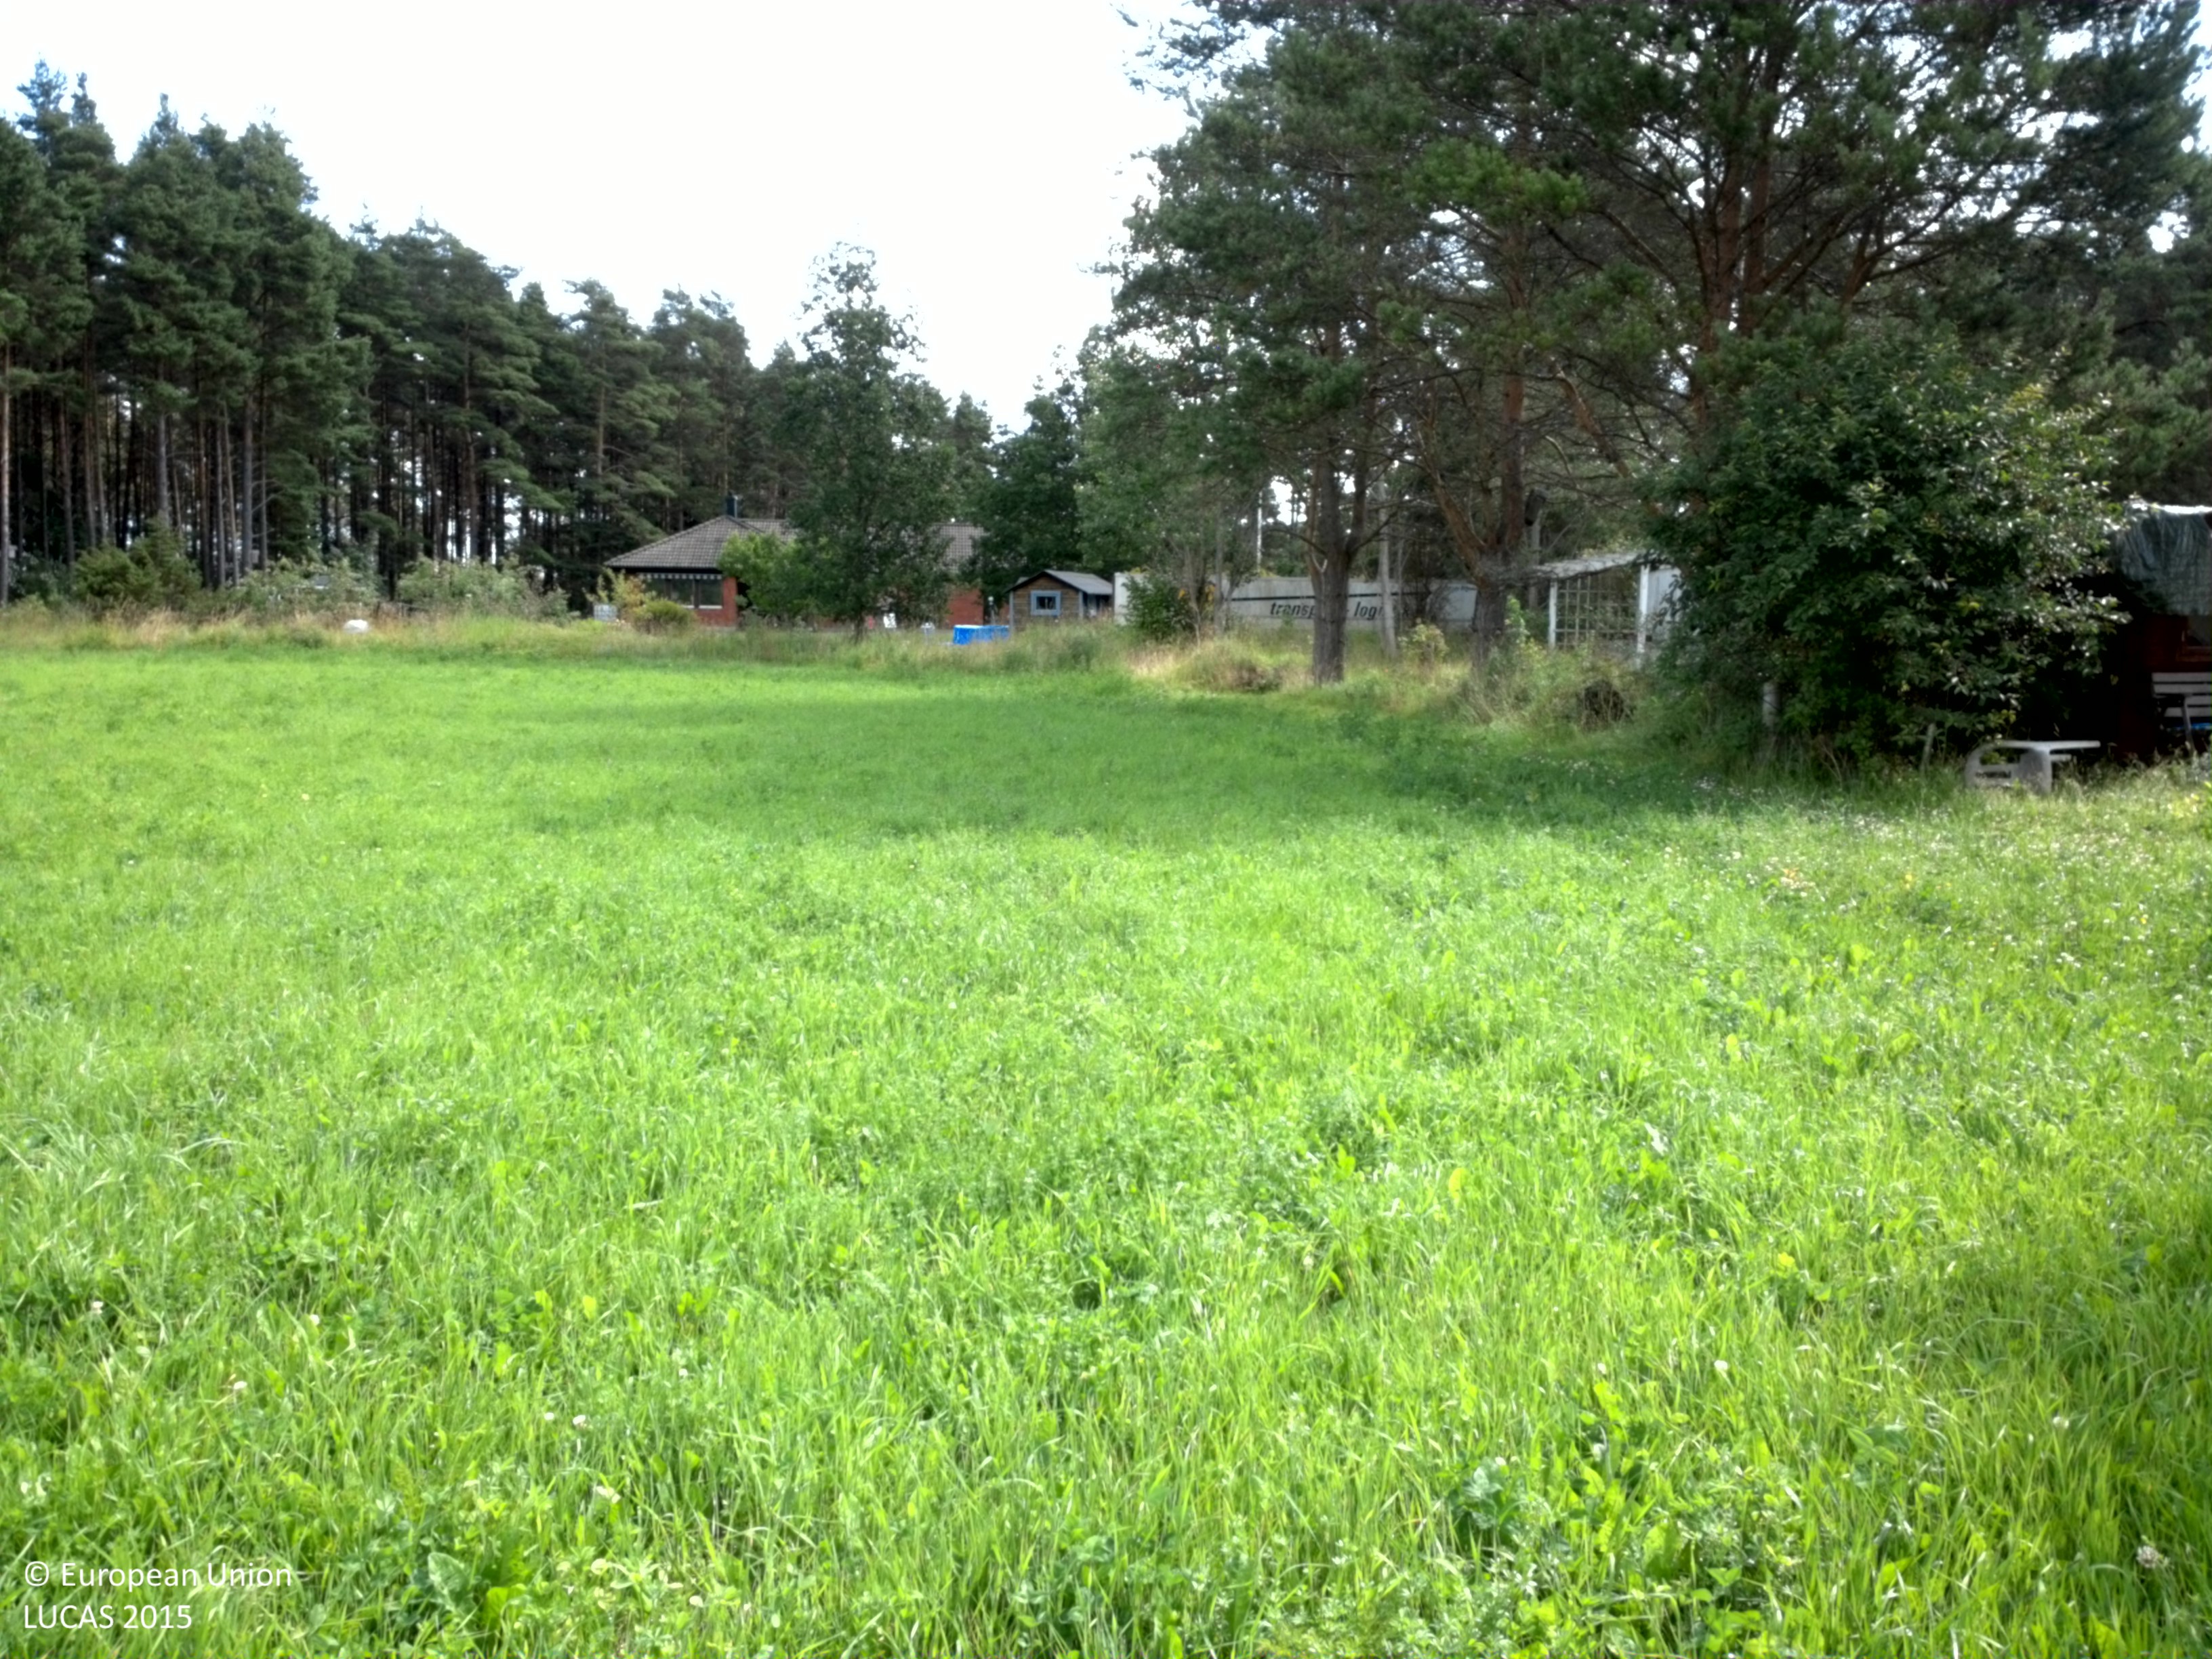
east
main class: Grassland
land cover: Grassland without tree/shrub cover
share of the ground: > 75 %
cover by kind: herbaceous plants 100 %
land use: Agriculture (excluding fallow land and kitchen gardens)
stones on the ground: < 10 %
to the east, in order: Grassland without tree/shrub cover; Pine dominated mixed woodland; Paved roads, cycling and walking lanes; Pine dominated mixed woodland; Grassland without tree/shrub cover; Tracks; Managed hedges; Paved roads, cycling and walking lanes; Grassland with sparse tree/shrub cover; Fences; Pine dominated coniferous woodland
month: July
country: SE
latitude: 57.5688
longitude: 18.5183
